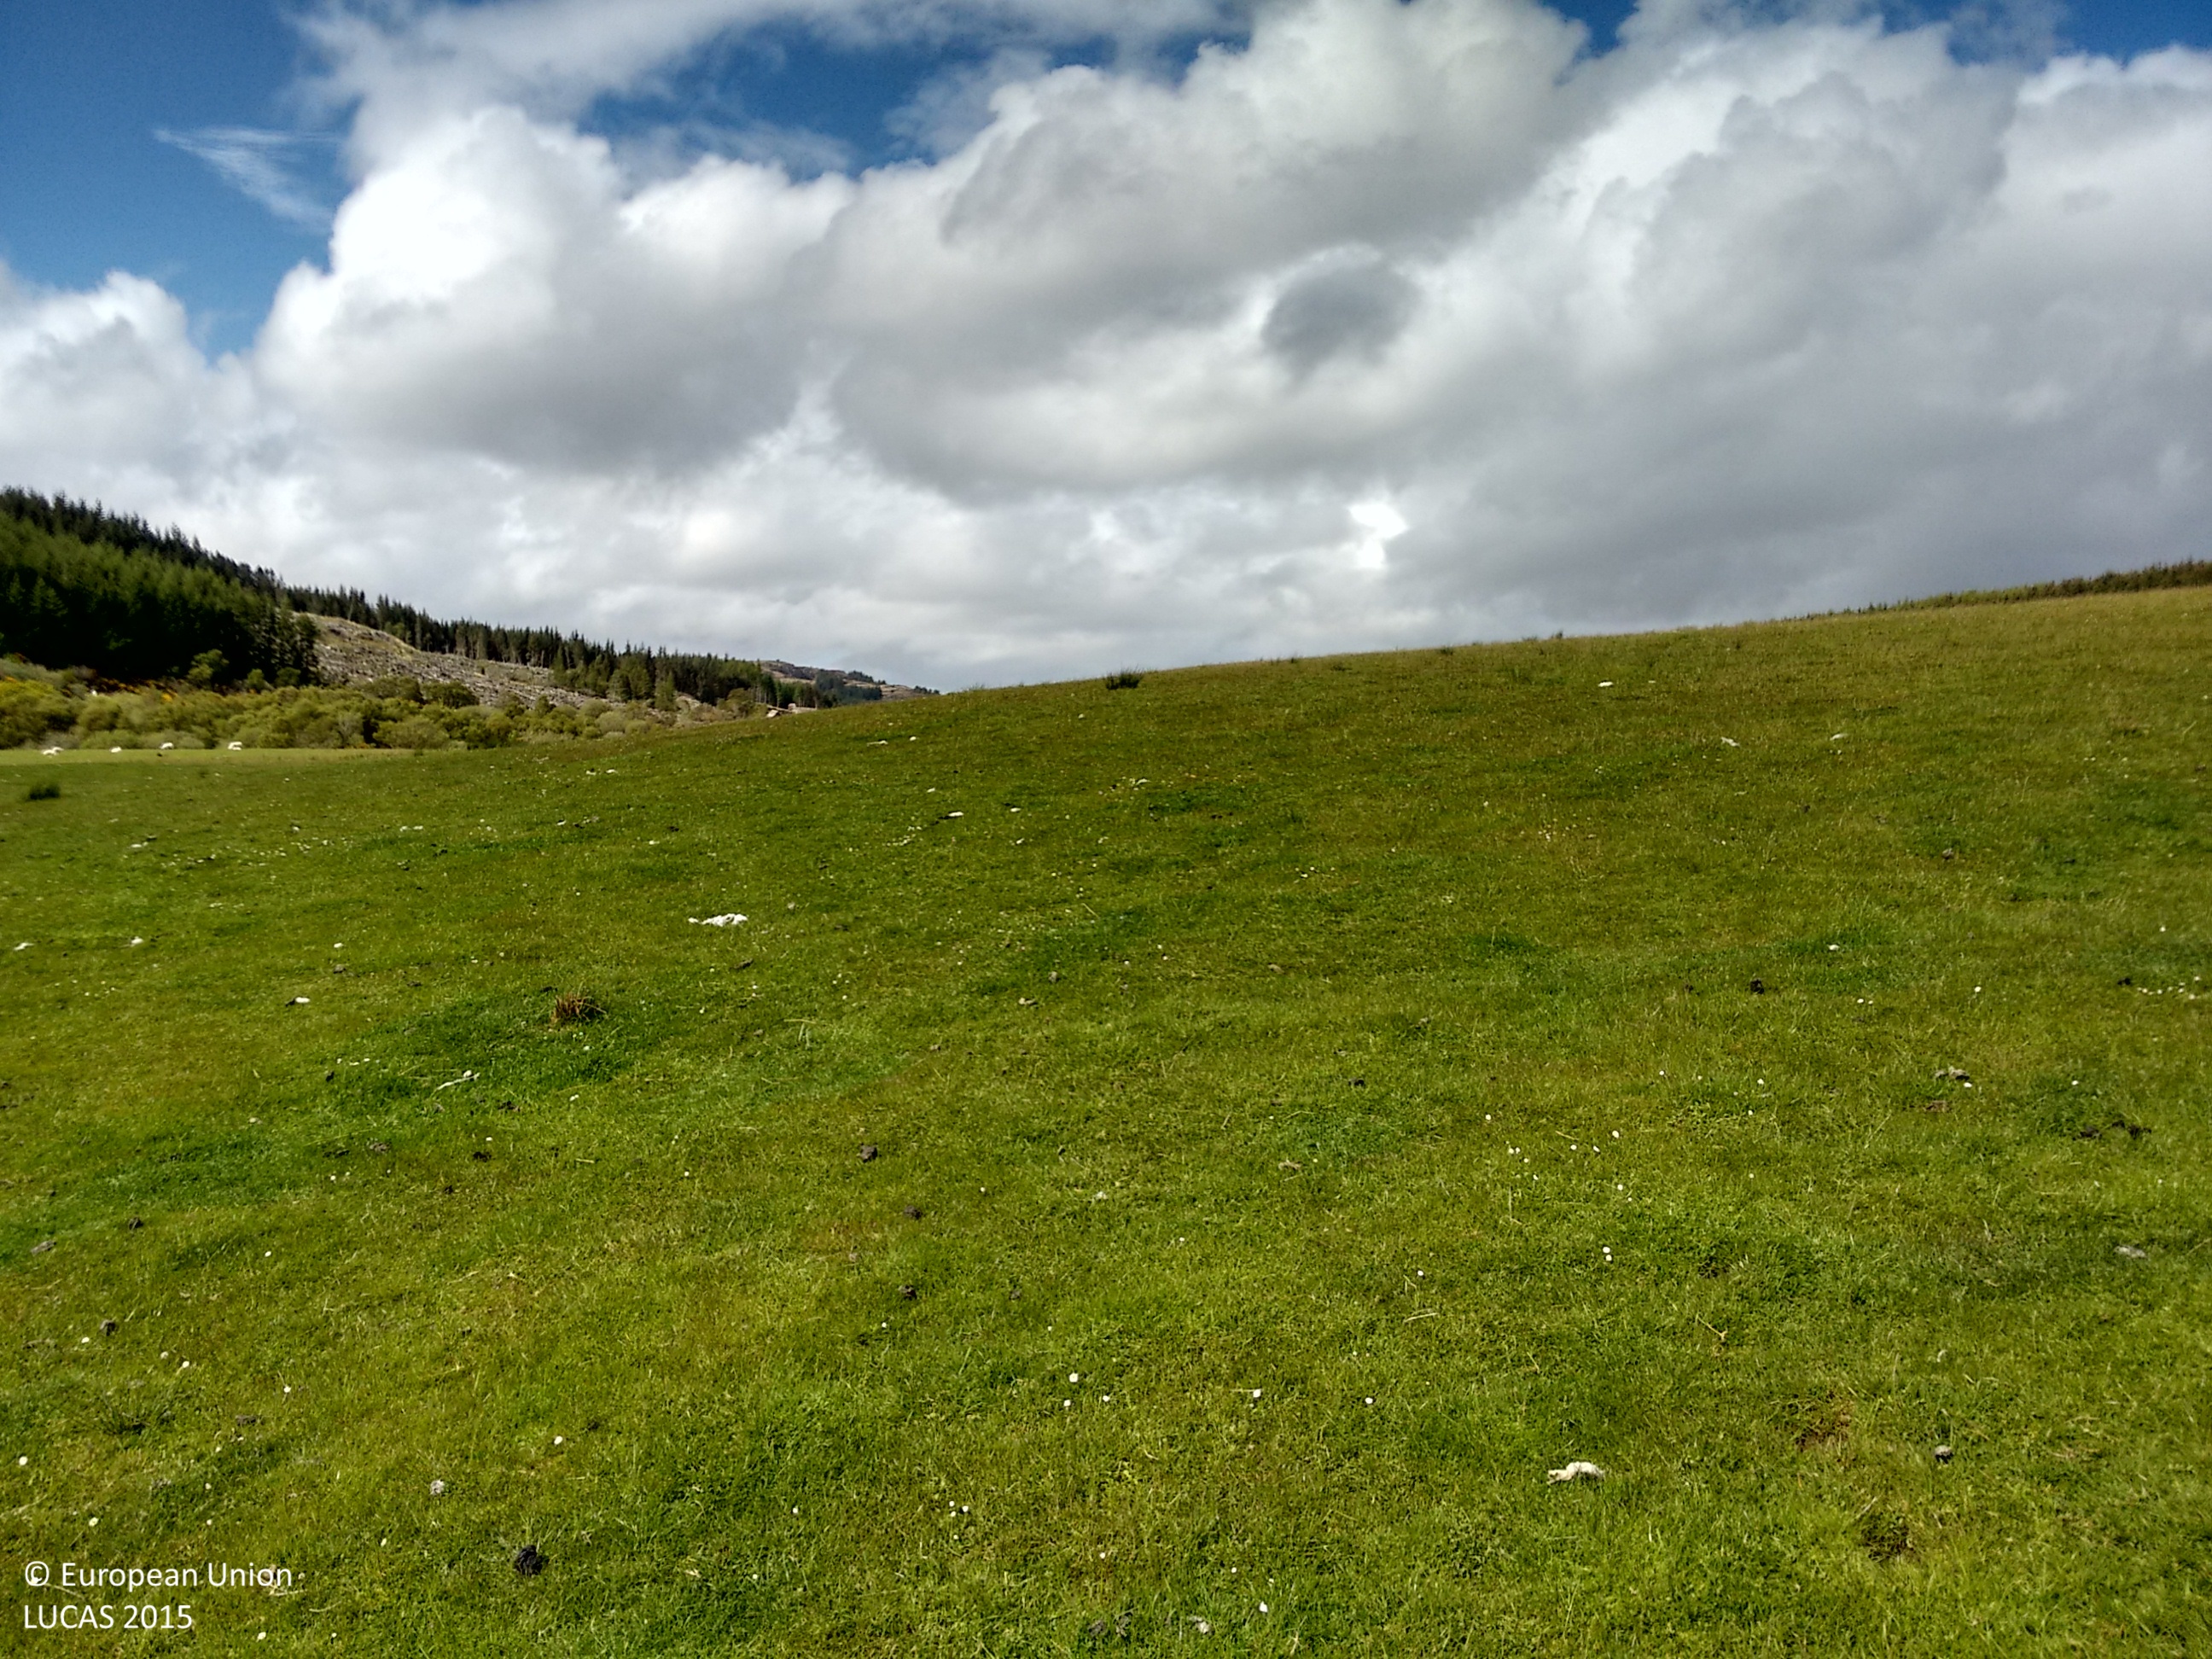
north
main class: Grassland
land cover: Grassland without tree/shrub cover
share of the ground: > 75 %
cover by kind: herbaceous plants 100 %
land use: Agriculture (excluding fallow land and kitchen gardens)
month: May
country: GB
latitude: 55.8695
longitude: -5.2832
